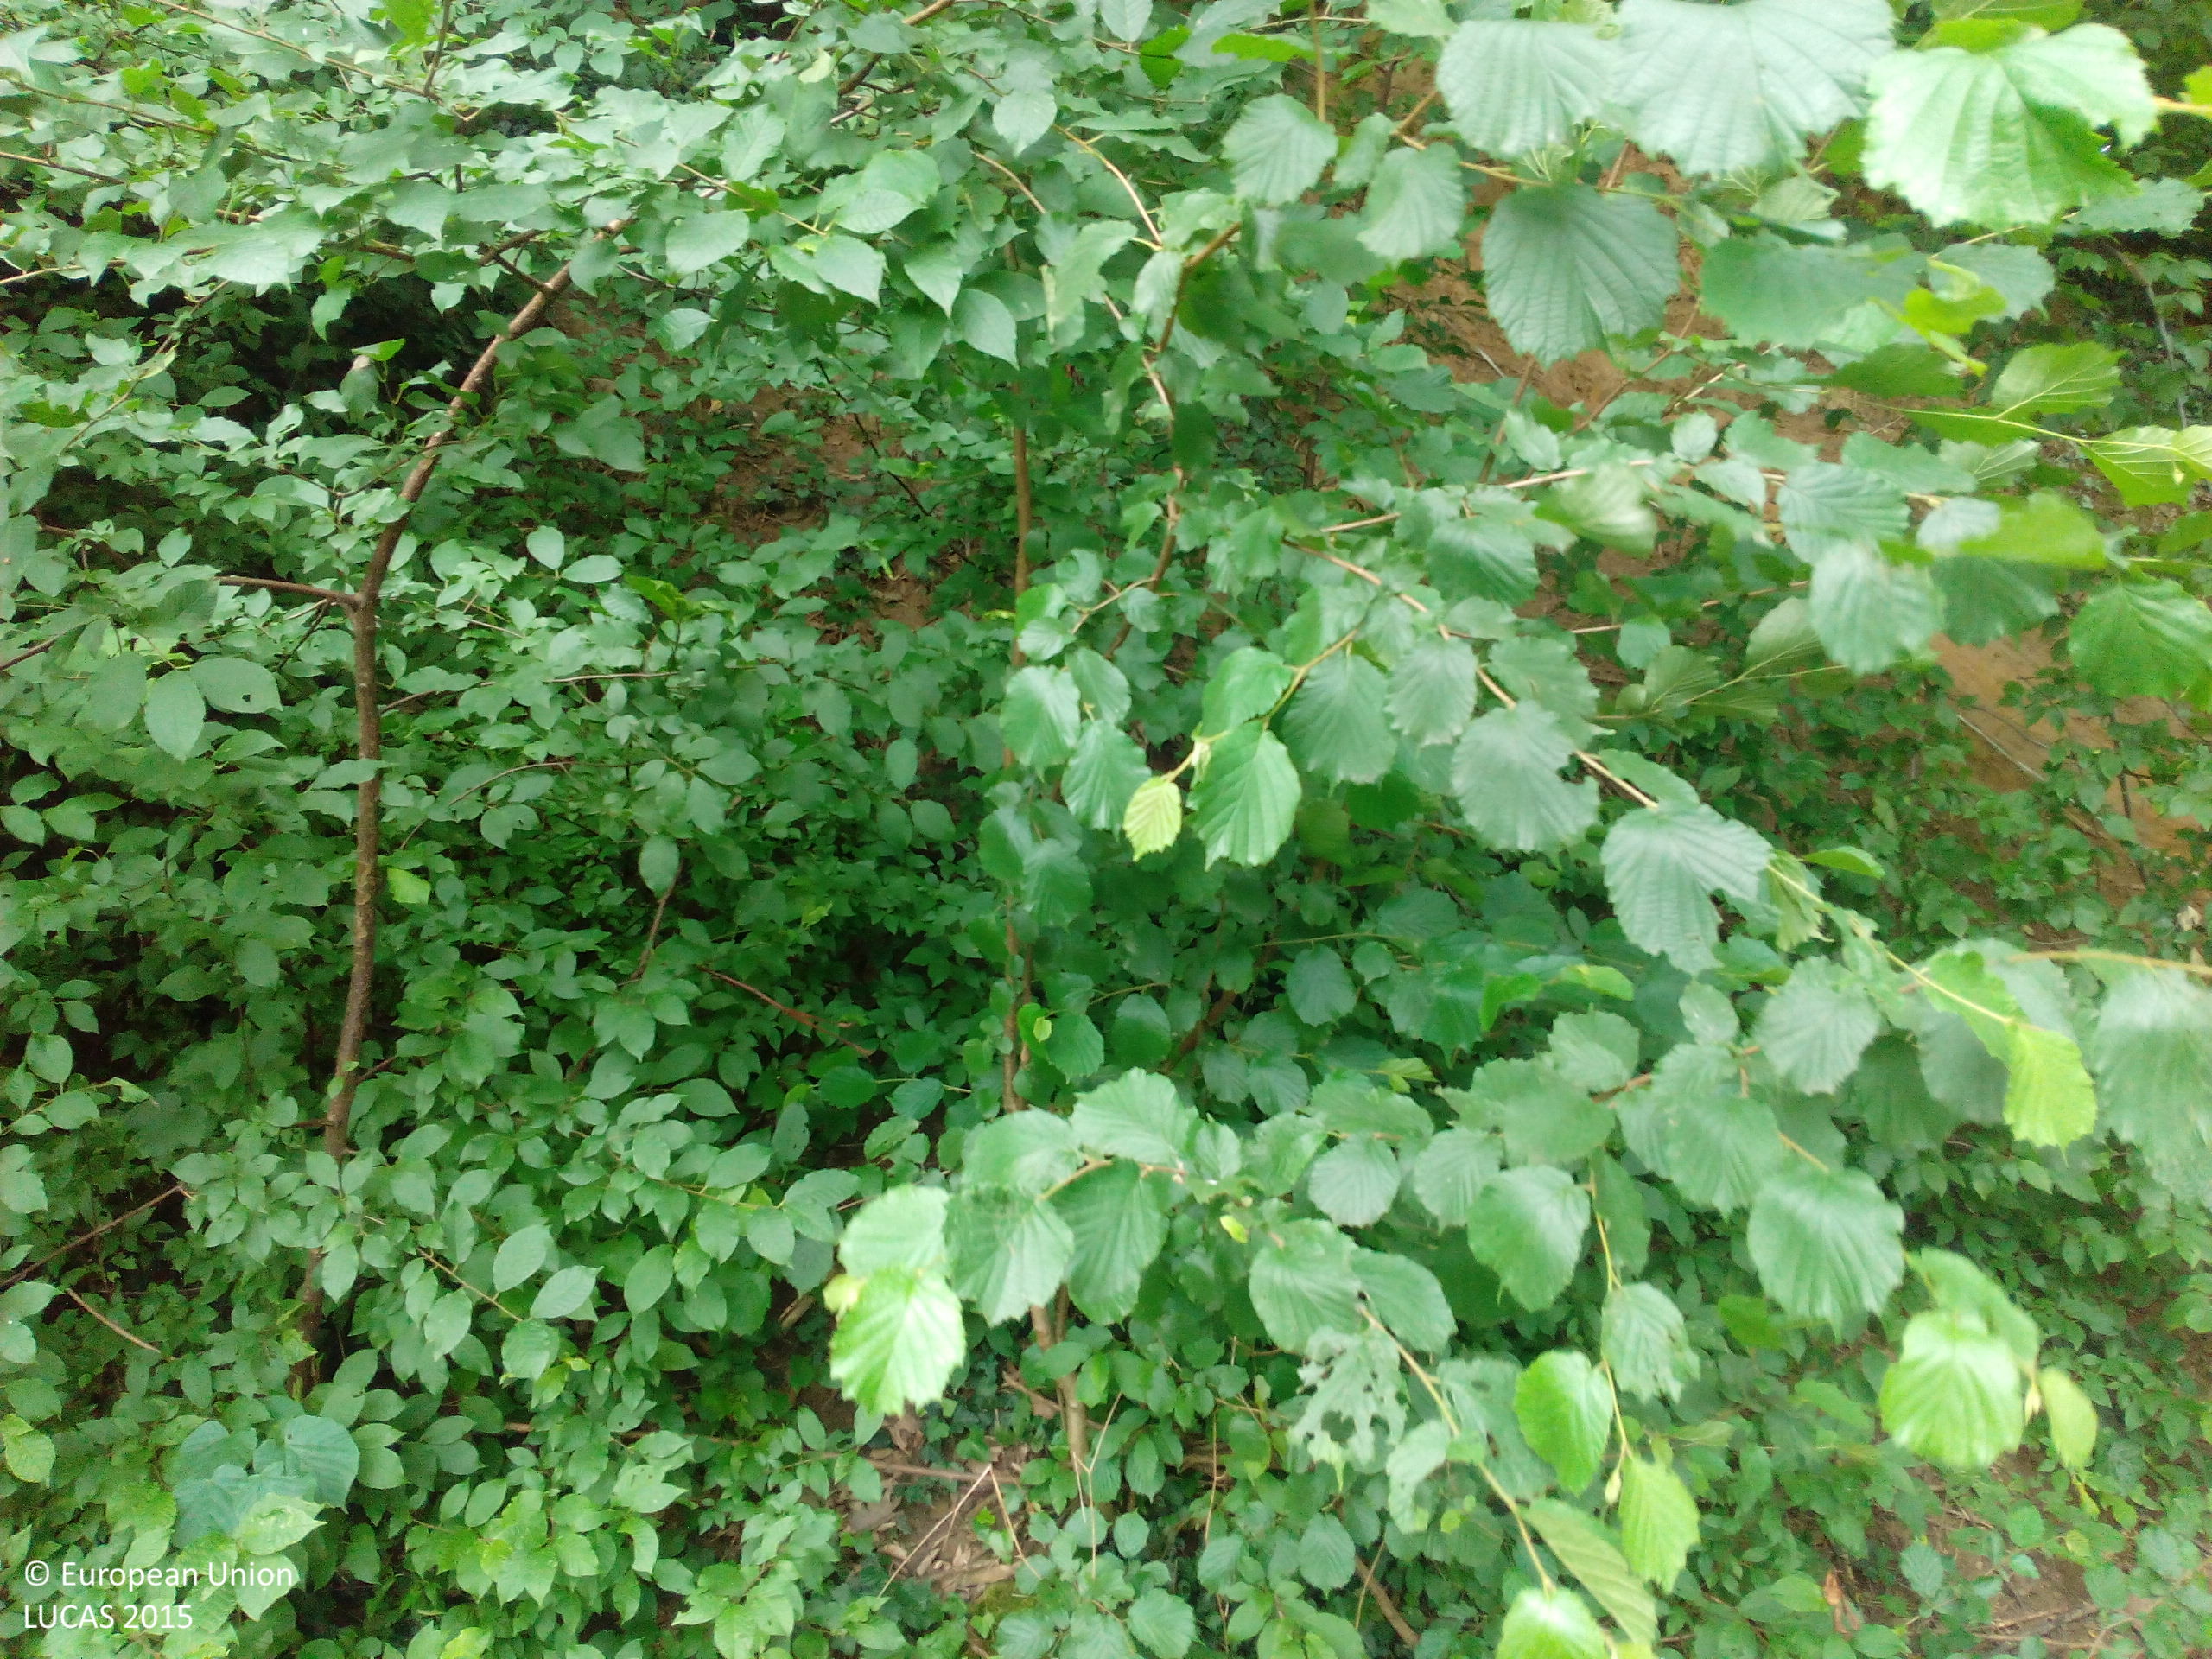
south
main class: Woodland
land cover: Broadleaved woodland
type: mesophytic deciduous forest
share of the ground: > 75 %
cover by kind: broadleaved forest trees 80 %, herbaceous plants 10 %, shrubs 5 %, consolidated bare surface 5 %
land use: Abandoned areas
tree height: > 5 m
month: June
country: DE
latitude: 48.6209
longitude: 8.0880
